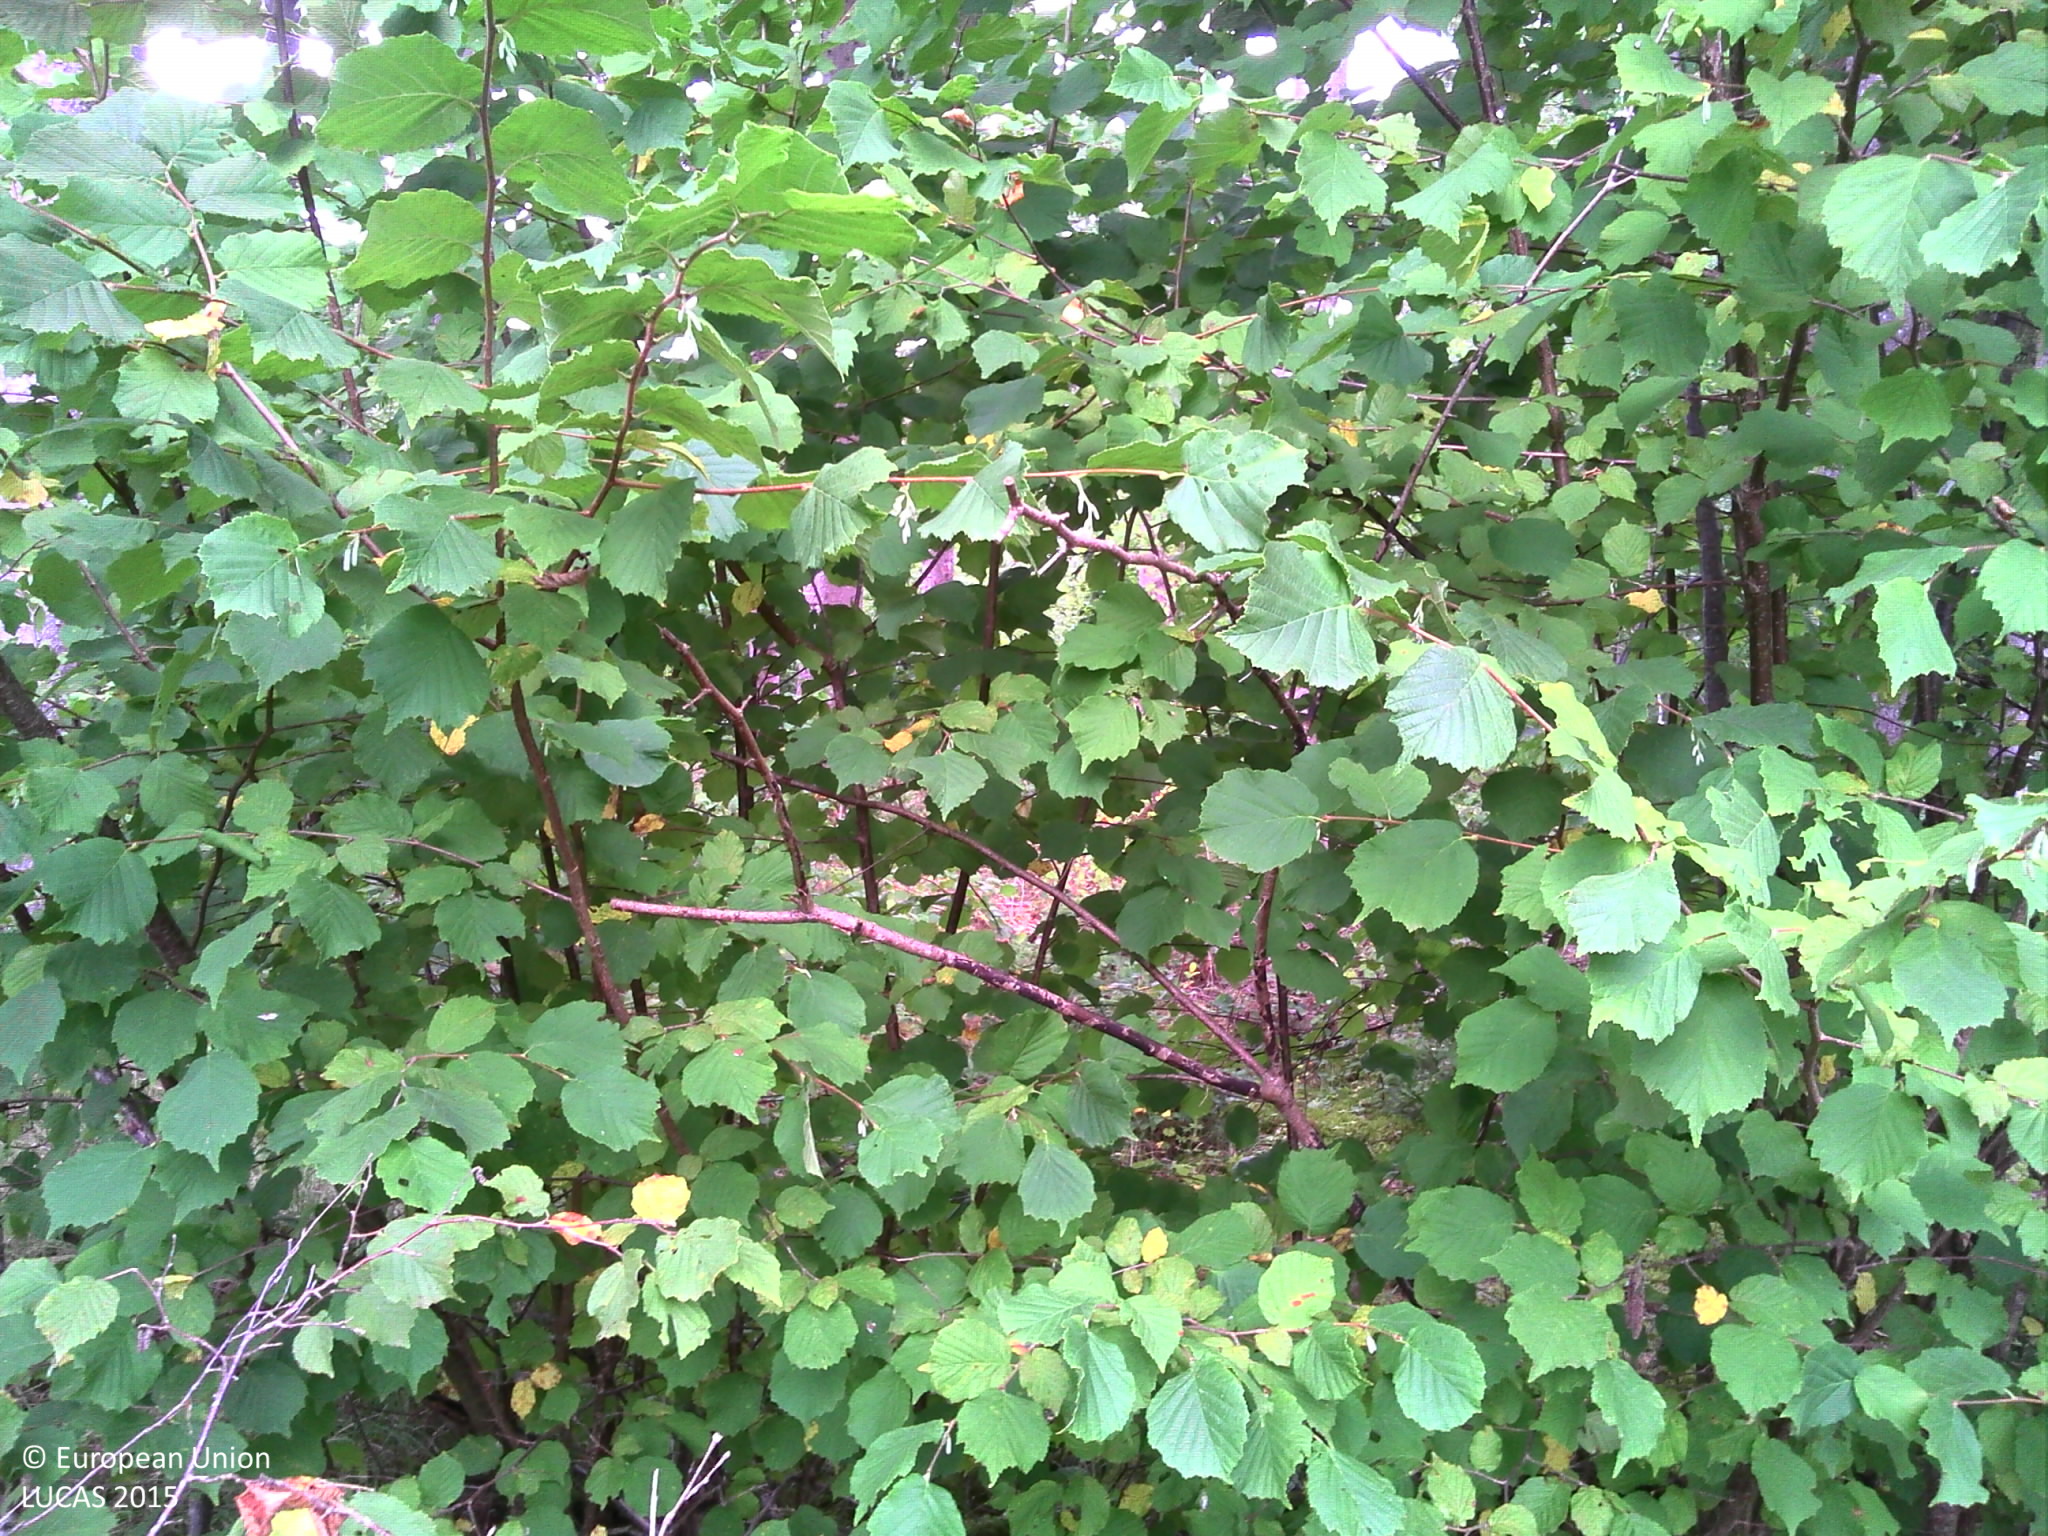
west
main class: Woodland
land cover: Spruce dominated mixed woodland
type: exotic forest
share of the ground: > 75 %
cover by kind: broadleaved forest trees 55 %, coniferous forest trees 30 %, herbaceous plants 10 %, lichens and mosses 5 %
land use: Forestry
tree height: > 5 m
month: August
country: FR
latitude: 47.7382
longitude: 4.7583
